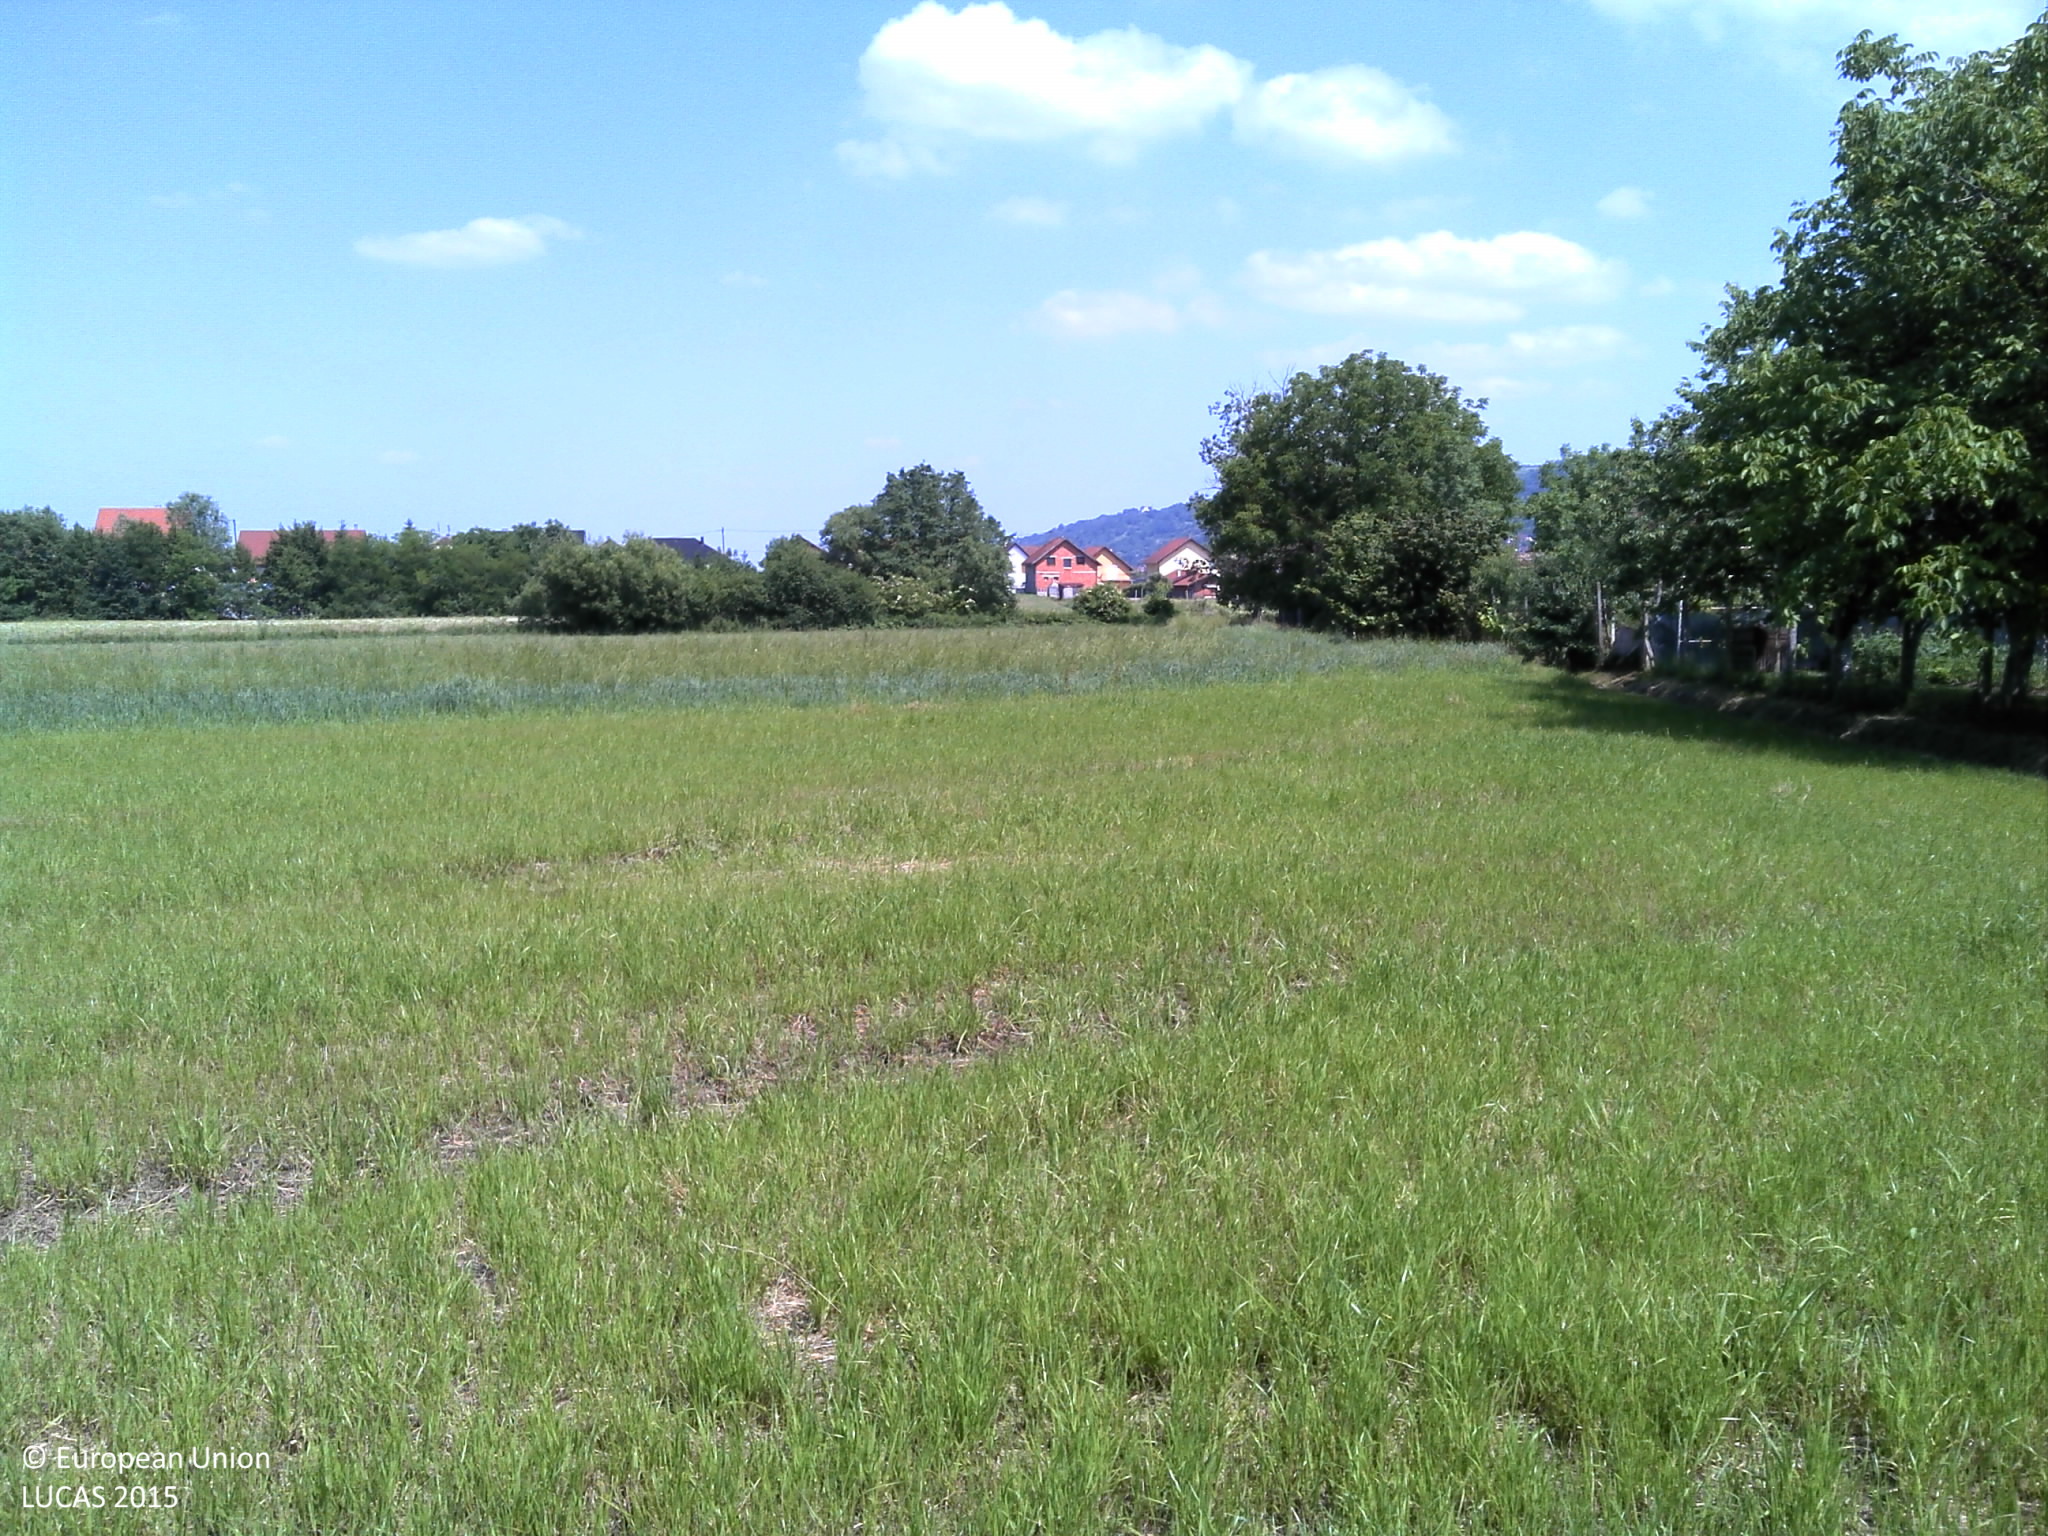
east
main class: Grassland
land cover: Grassland without tree/shrub cover
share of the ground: > 75 %
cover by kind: herbaceous plants 100 %
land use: Abandoned areas
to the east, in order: Grassland without tree/shrub cover; Oats; Maize; Shrubland with sparse tree cover; Ditches and canals; Maize; Barley; Rivers and streams; Fences
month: June
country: HR
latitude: 45.3355
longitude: 17.6451
